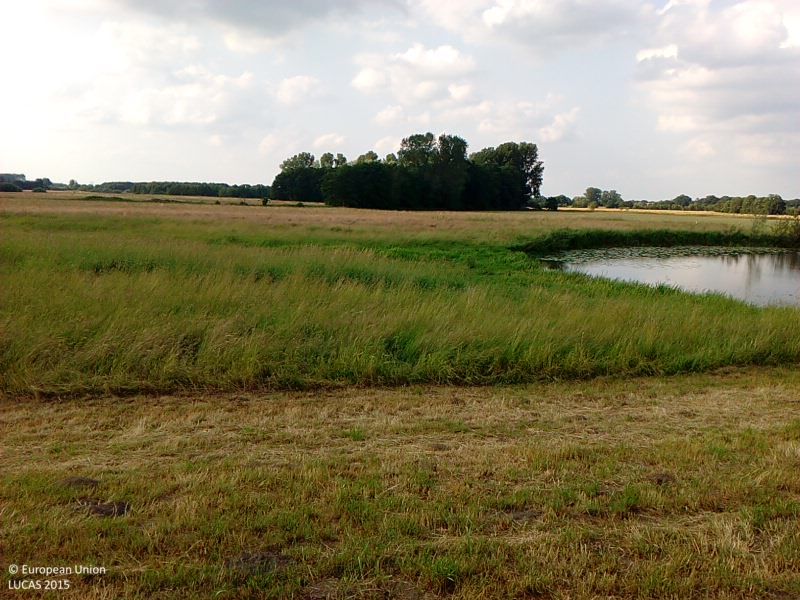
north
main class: Grassland
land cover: Grassland without tree/shrub cover
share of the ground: > 75 %
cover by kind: herbaceous plants 100 %
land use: Agriculture (excluding fallow land and kitchen gardens)
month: July
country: DE
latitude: 52.6730
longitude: 7.4123
